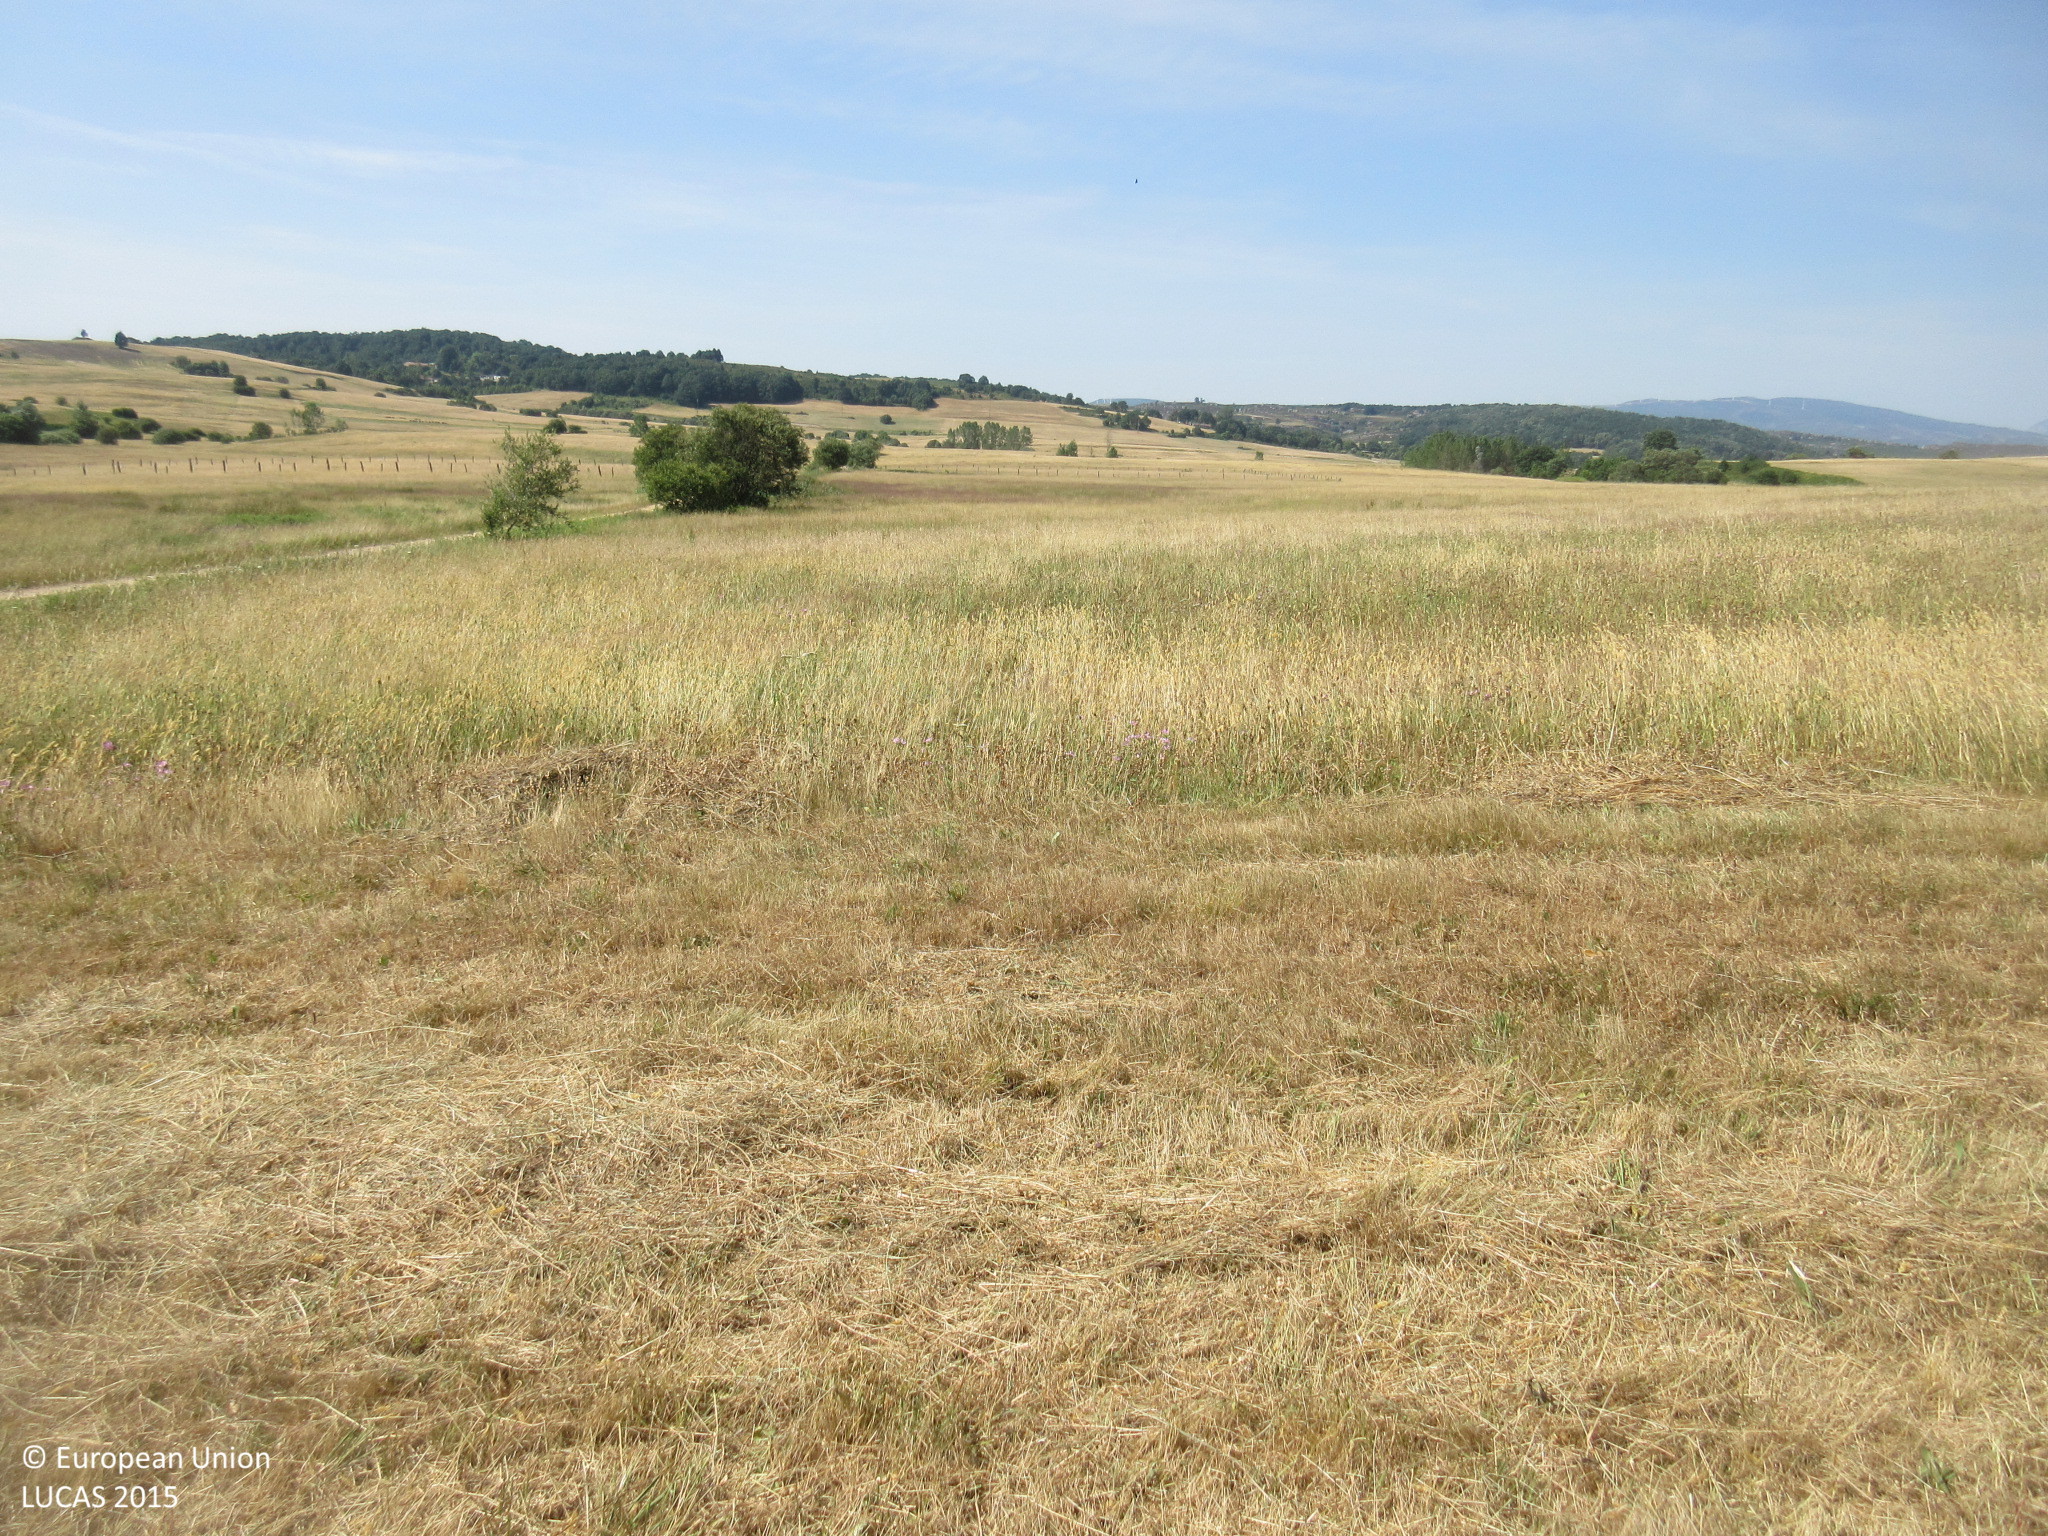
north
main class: Grassland
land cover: Grassland without tree/shrub cover
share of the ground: > 75 %
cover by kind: herbaceous plants 100 %
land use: Agriculture (excluding fallow land and kitchen gardens)
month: July
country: ES
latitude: 42.9614
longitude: -3.8362
